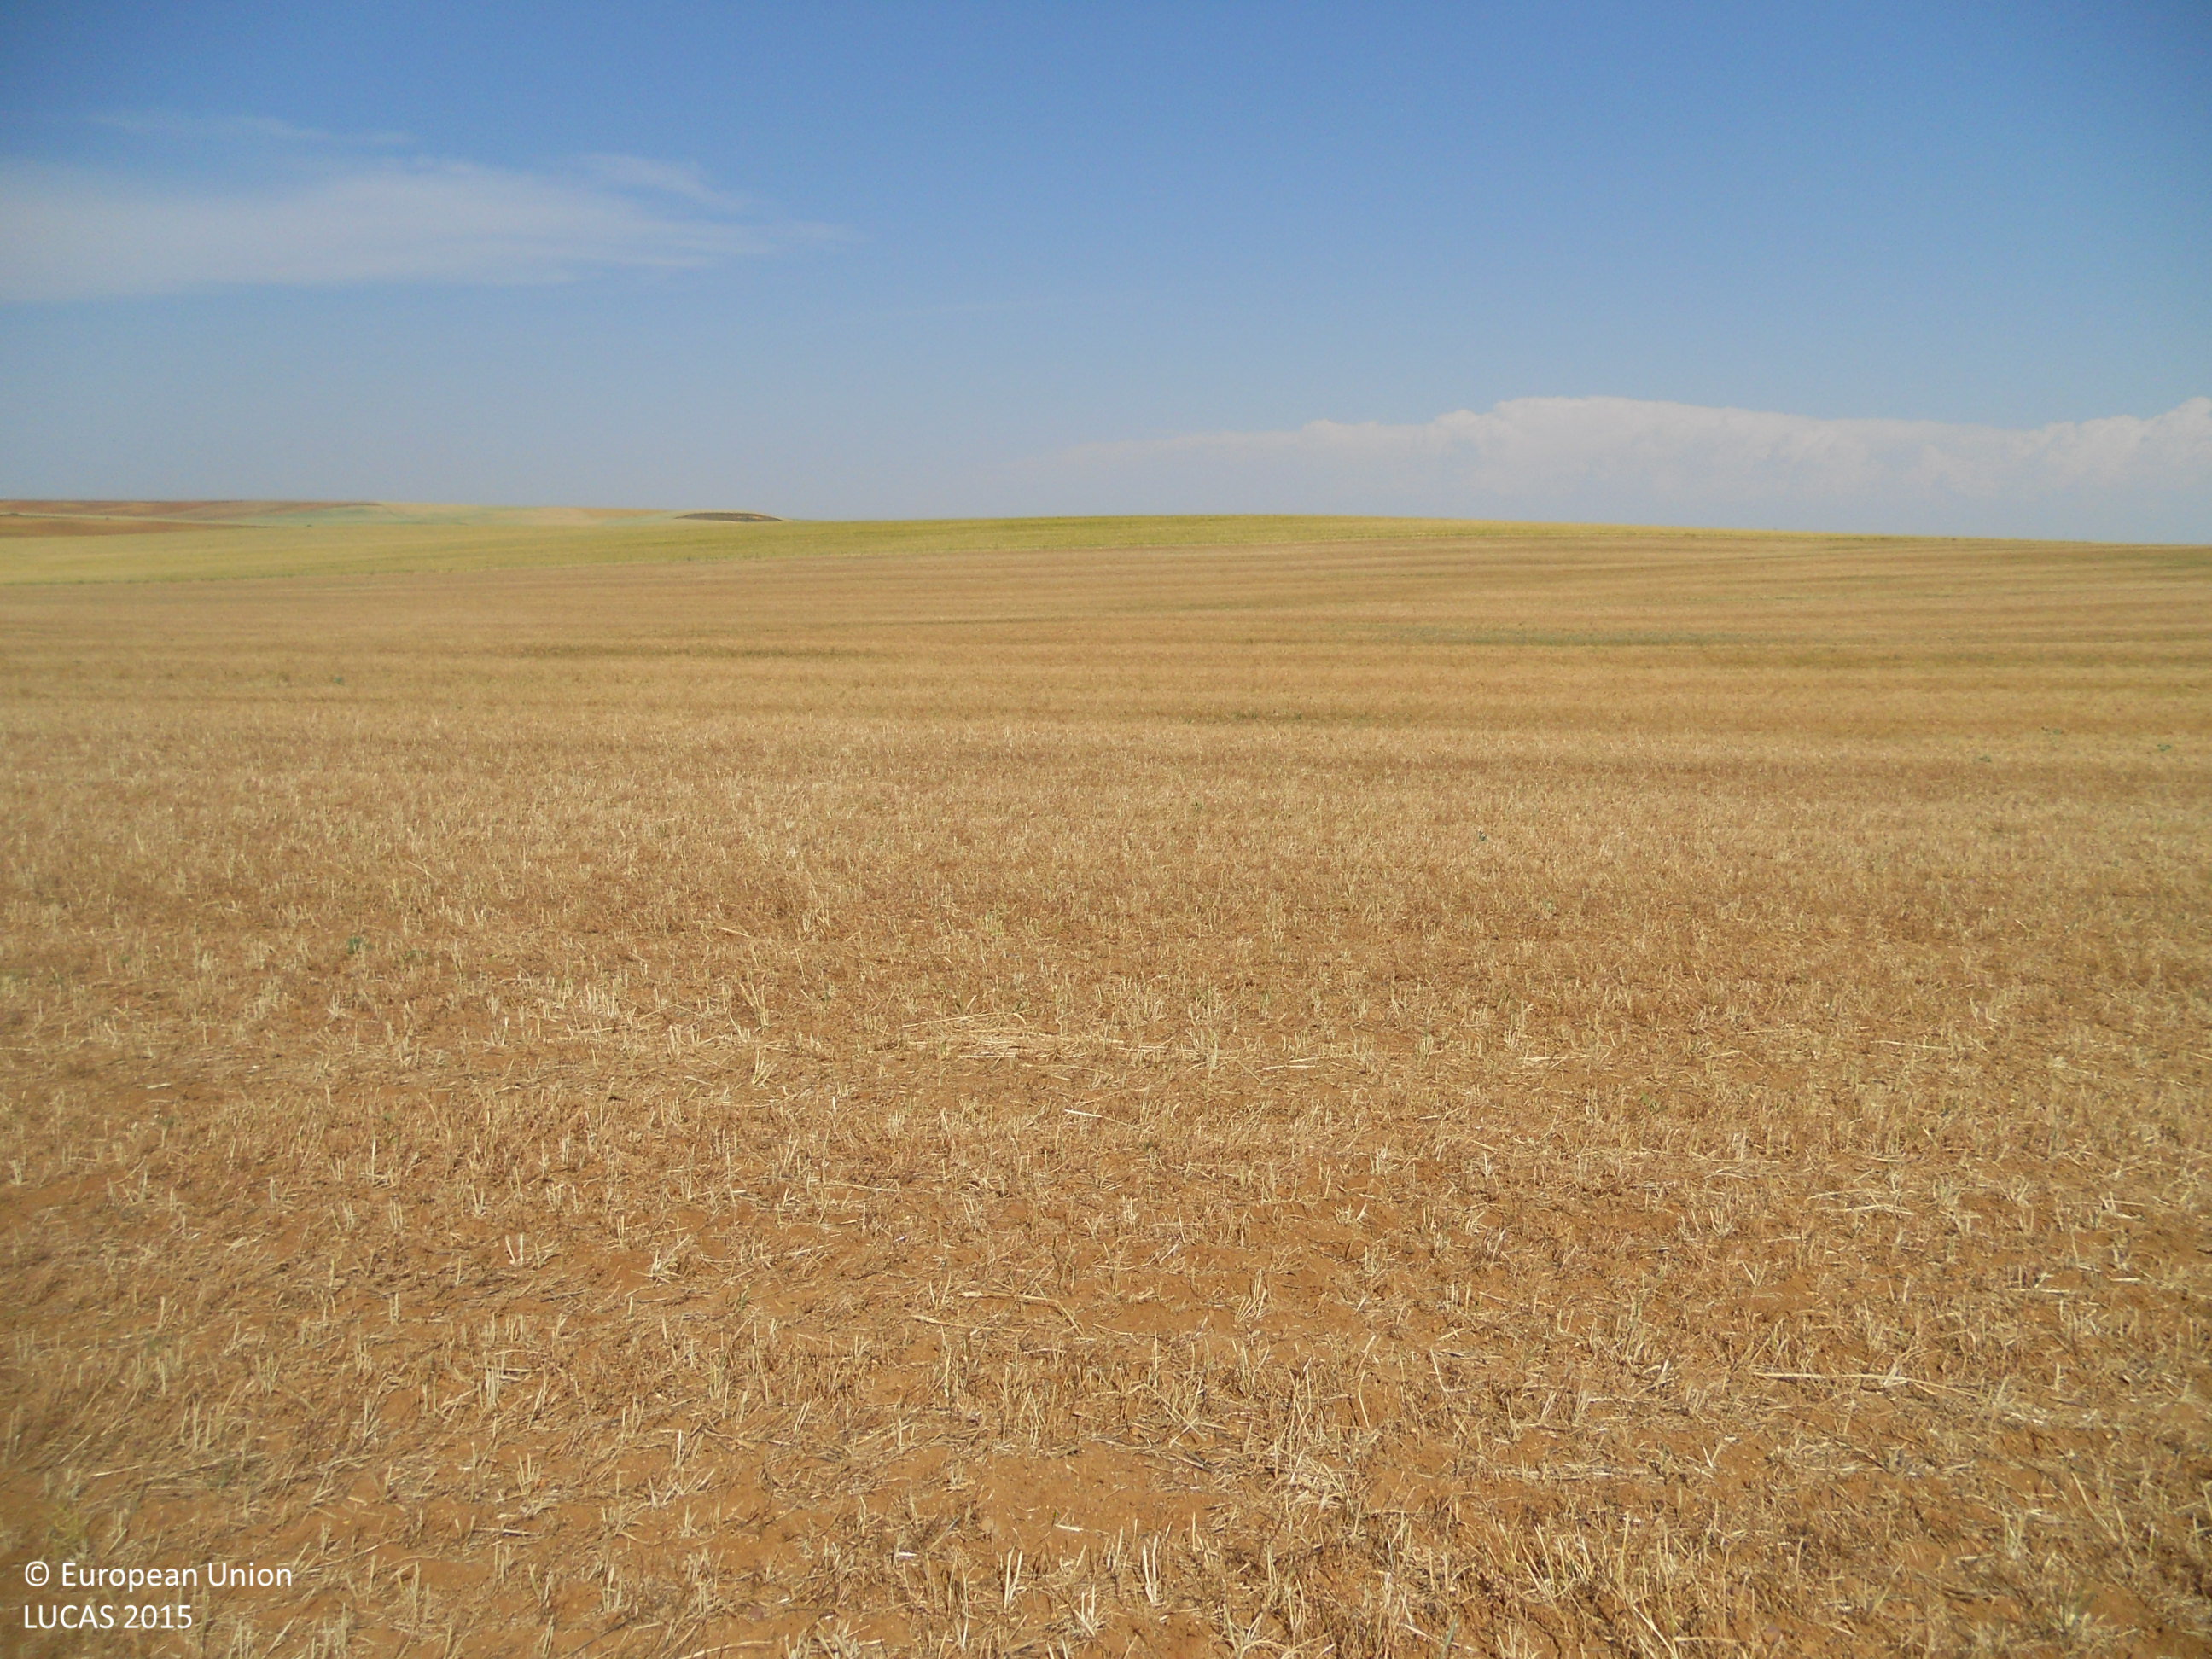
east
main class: Cropland
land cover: Mixed cereals for fodder
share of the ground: < 10 %
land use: Agriculture (excluding fallow land and kitchen gardens)
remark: Harvested field
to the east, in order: Mixed cereals for fodder; Barley
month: June
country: ES
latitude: 42.1897
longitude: -5.4805
